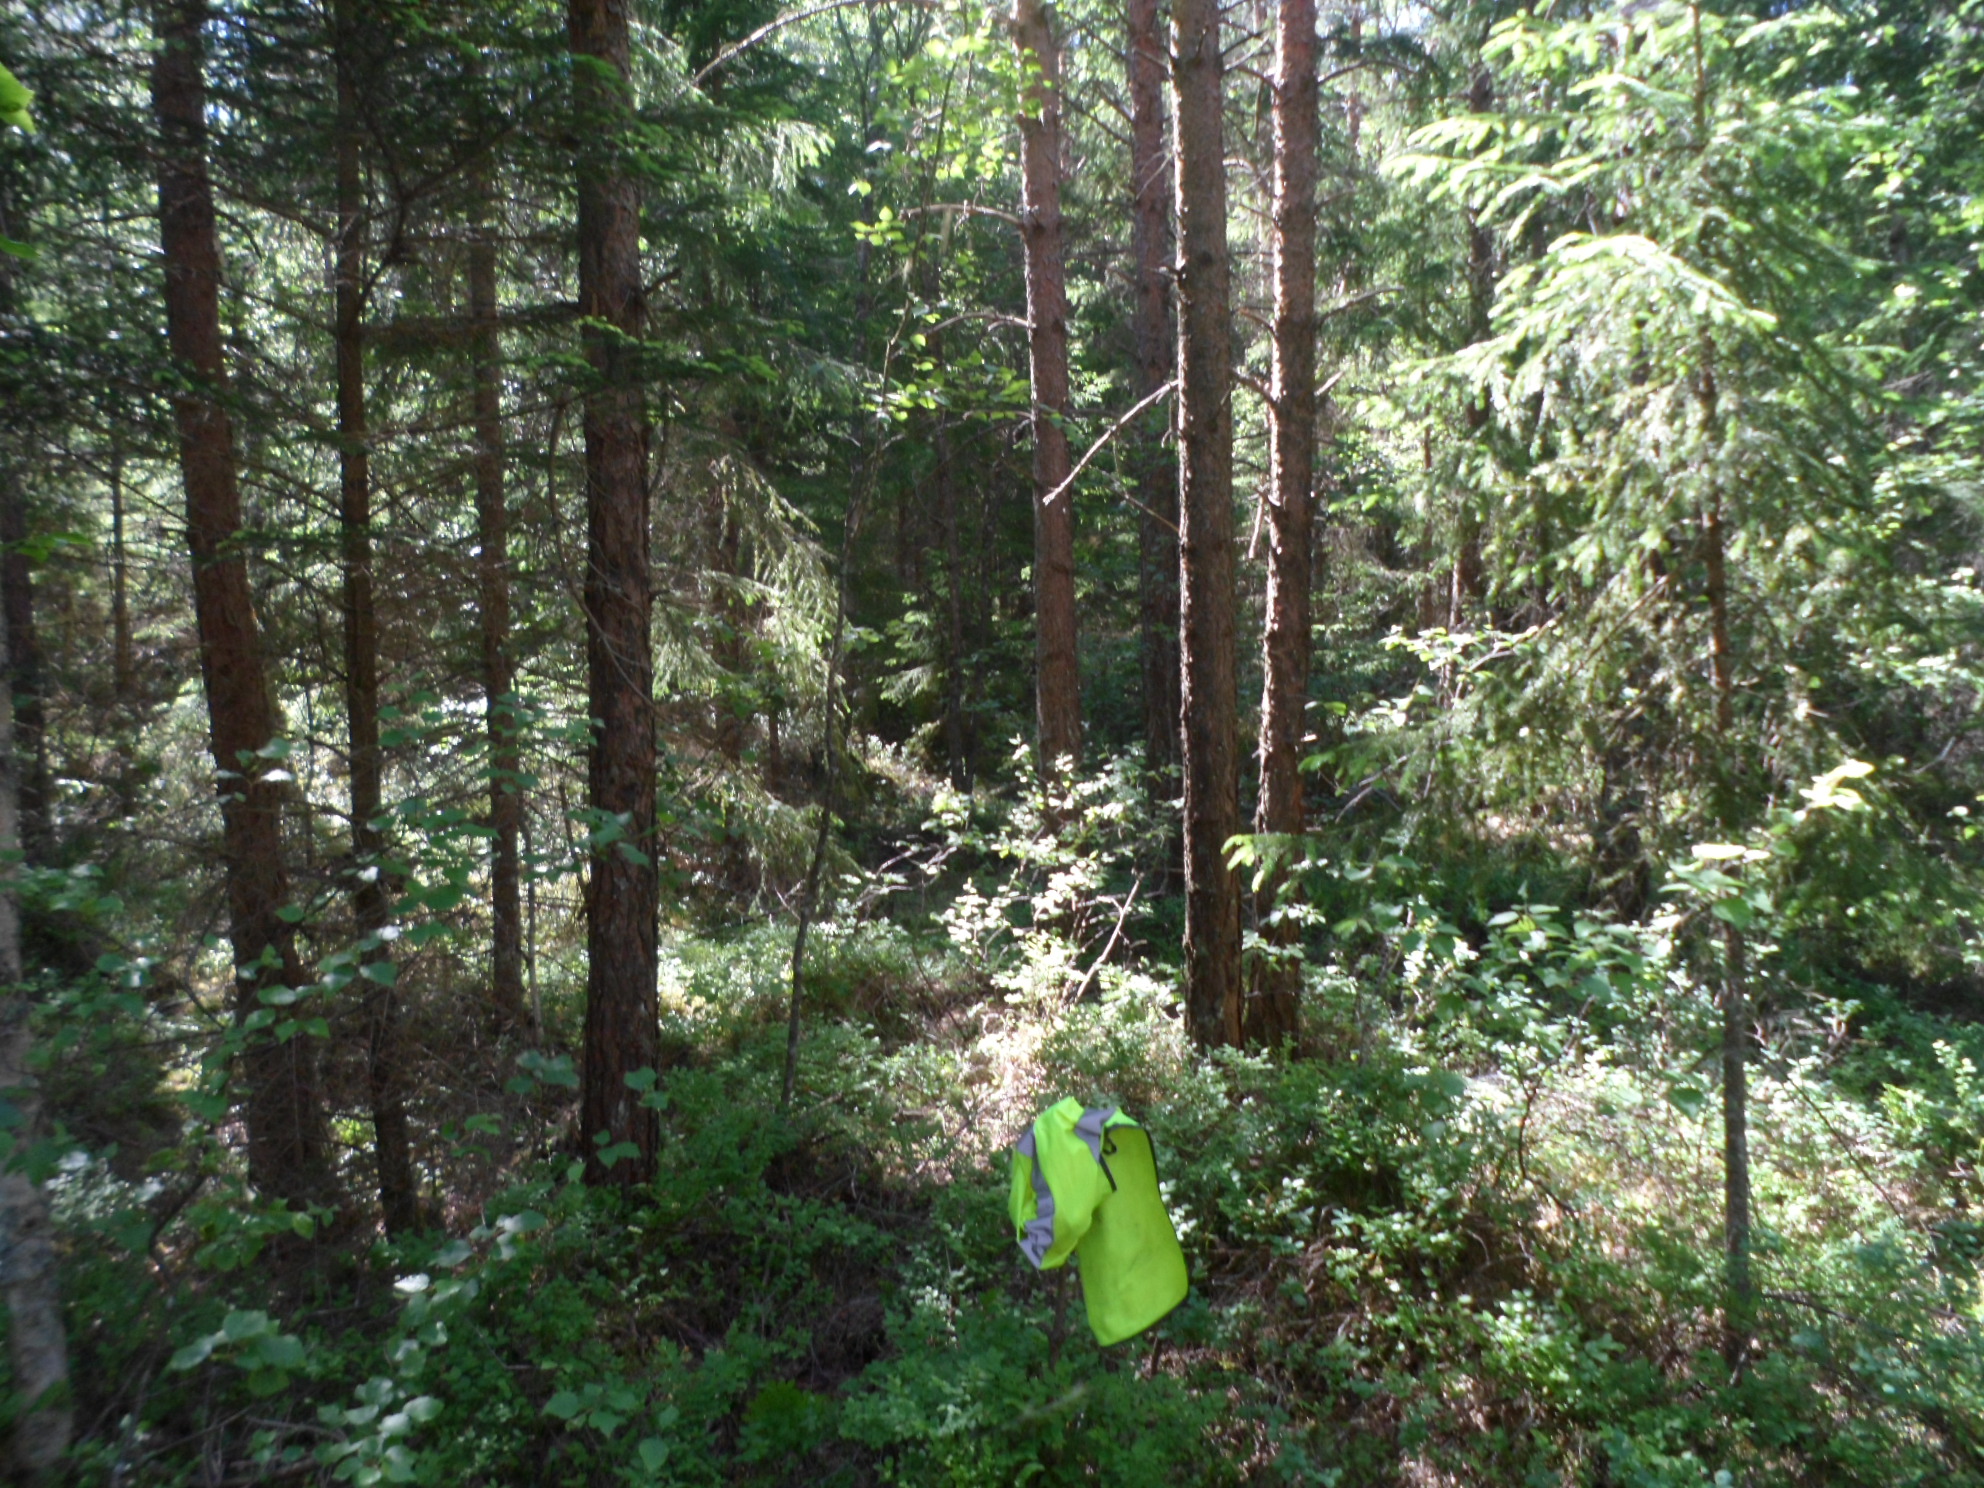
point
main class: Woodland
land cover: Pine dominated coniferous woodland
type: boreal forest
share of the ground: 50 - 75 %
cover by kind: coniferous forest trees 55 %, shrubs 20 %, broadleaved forest trees 10 %, lichens and mosses 10 %, herbaceous plants 5 %
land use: Forestry
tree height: > 5 m
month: July
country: SE
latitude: 57.1520
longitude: 14.5422
